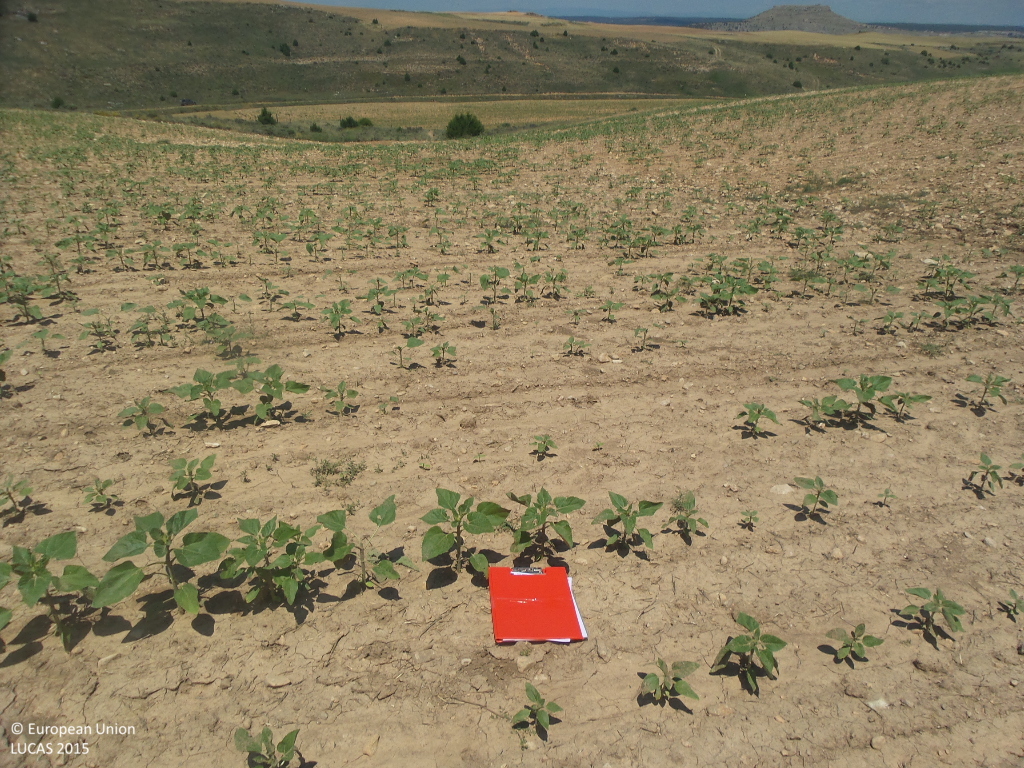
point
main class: Cropland
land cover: Sunflower
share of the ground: 10 - 25 %
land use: Agriculture (excluding fallow land and kitchen gardens)
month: June
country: ES
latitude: 41.4610
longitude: -3.0314
